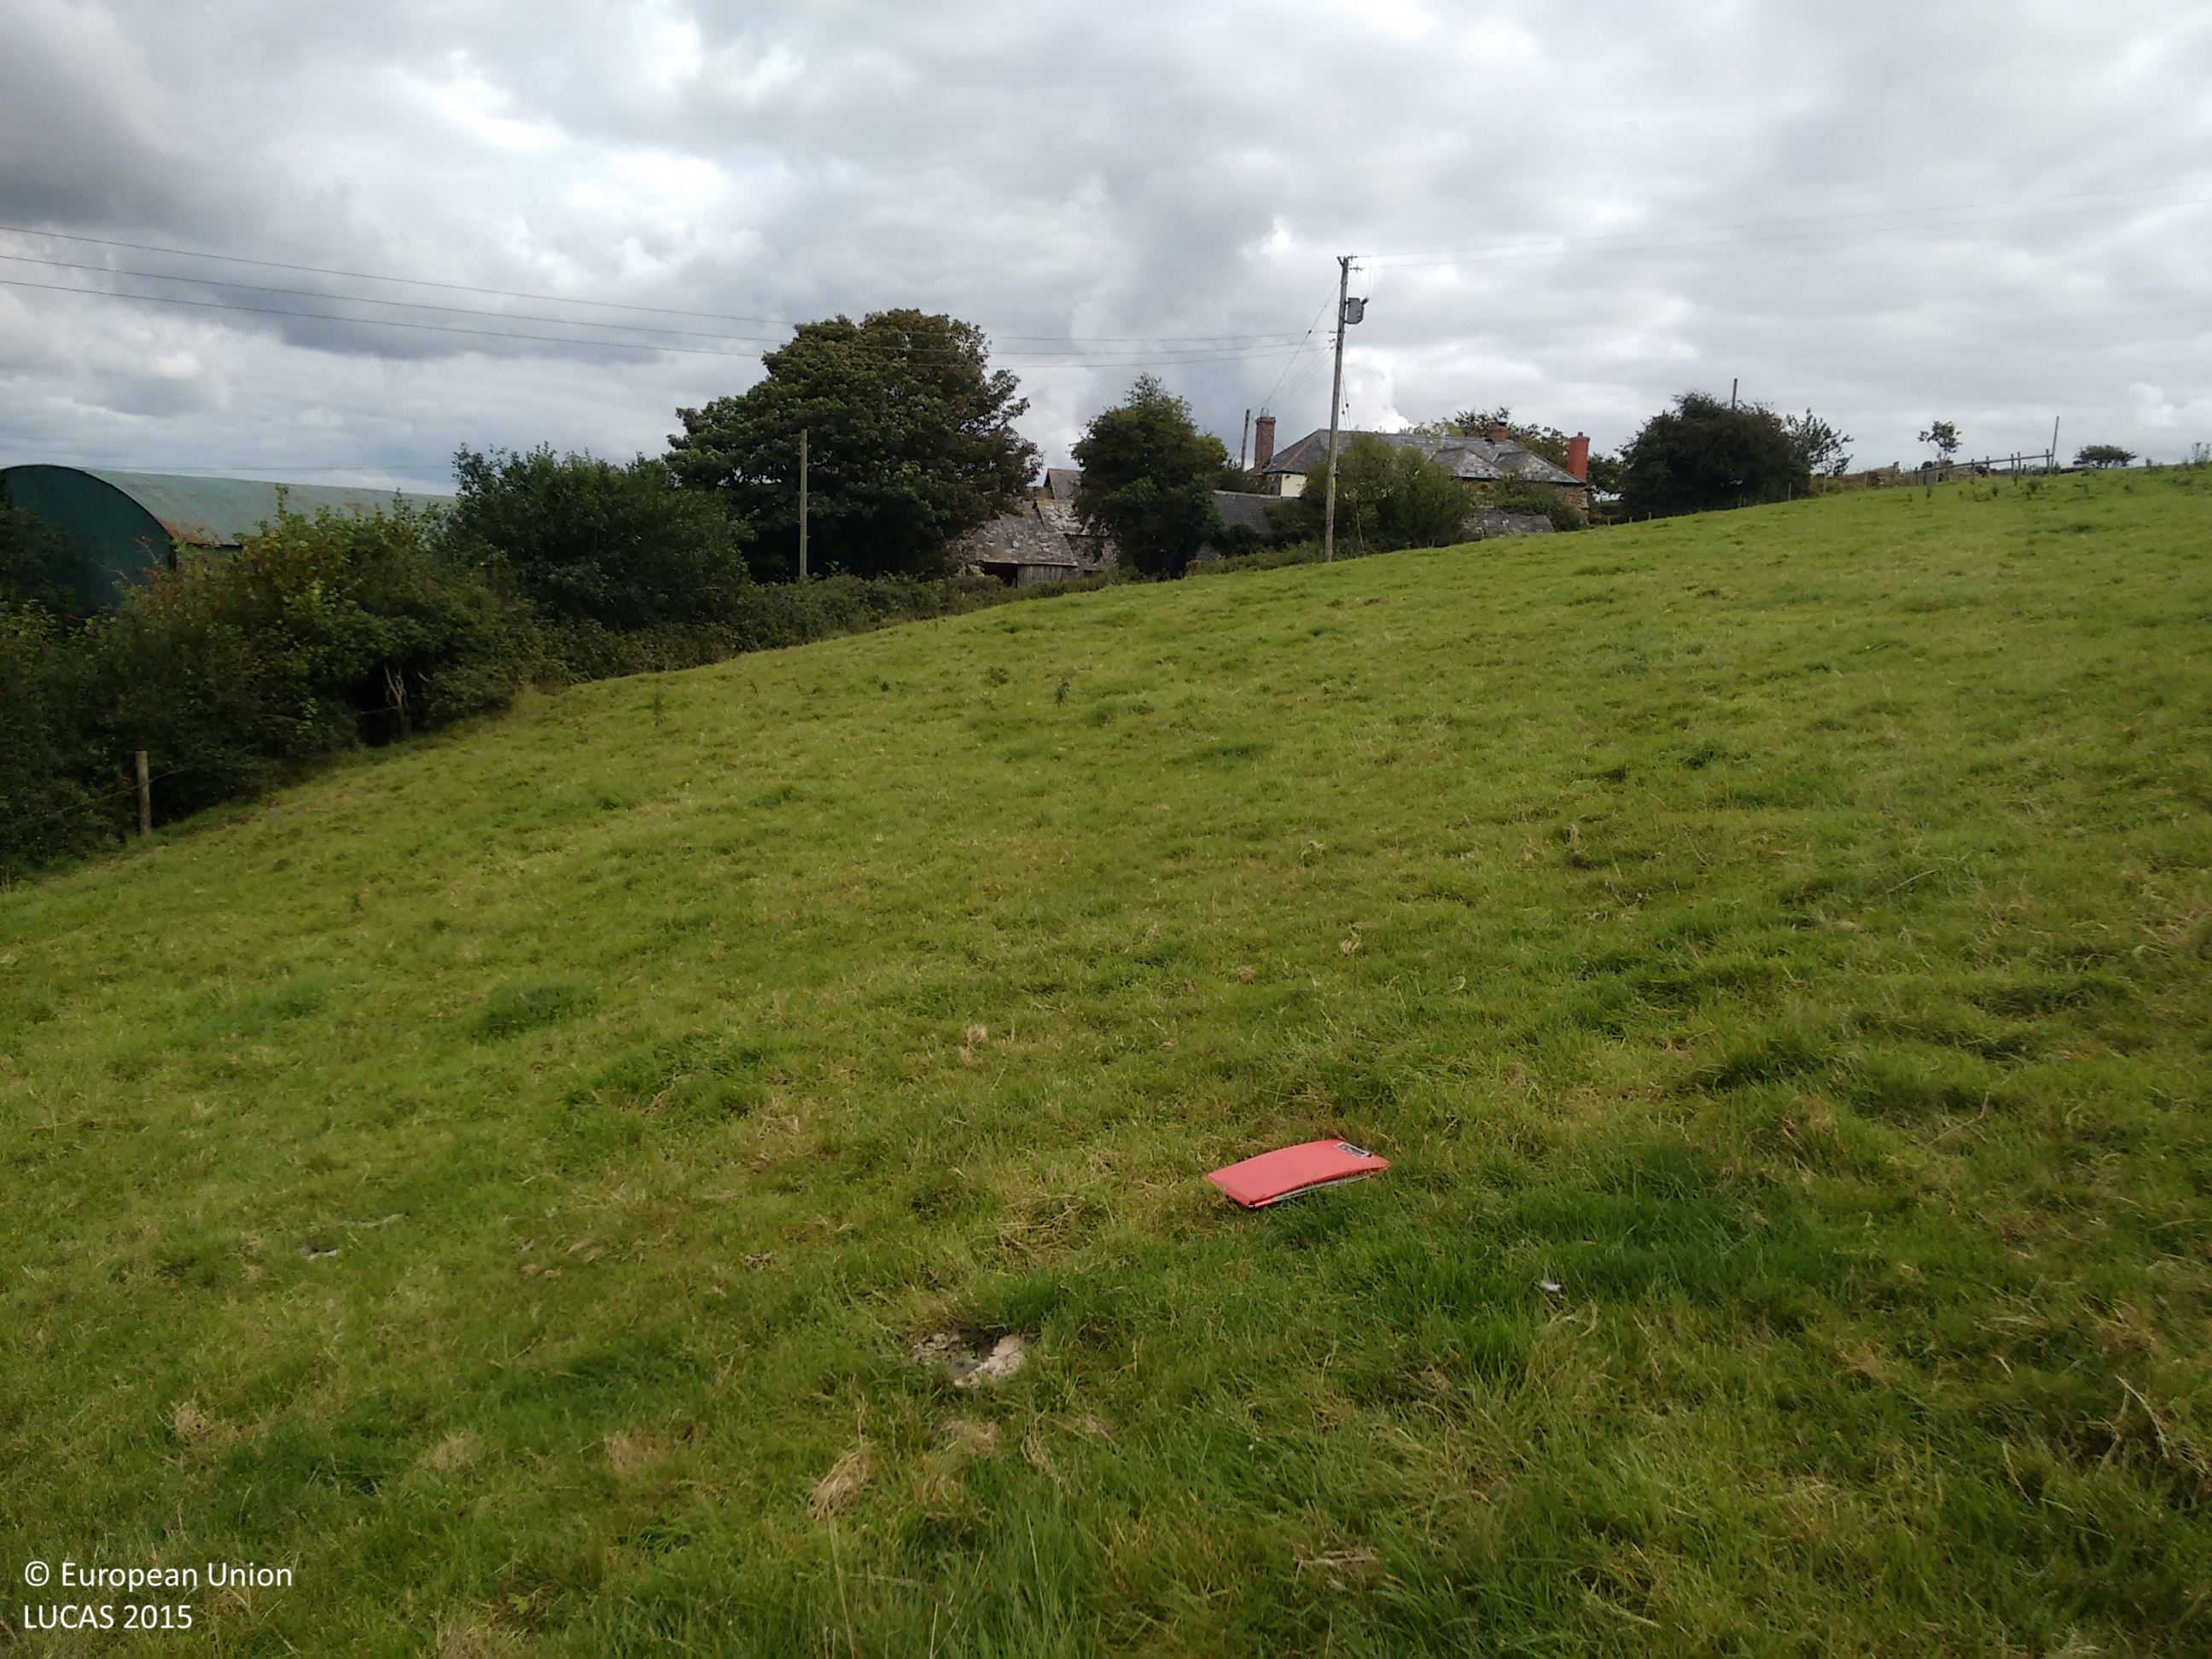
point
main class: Grassland
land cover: Grassland without tree/shrub cover
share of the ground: > 75 %
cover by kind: herbaceous plants 100 %
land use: Agriculture (excluding fallow land and kitchen gardens)
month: September
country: GB
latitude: 50.9086
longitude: -4.1047
